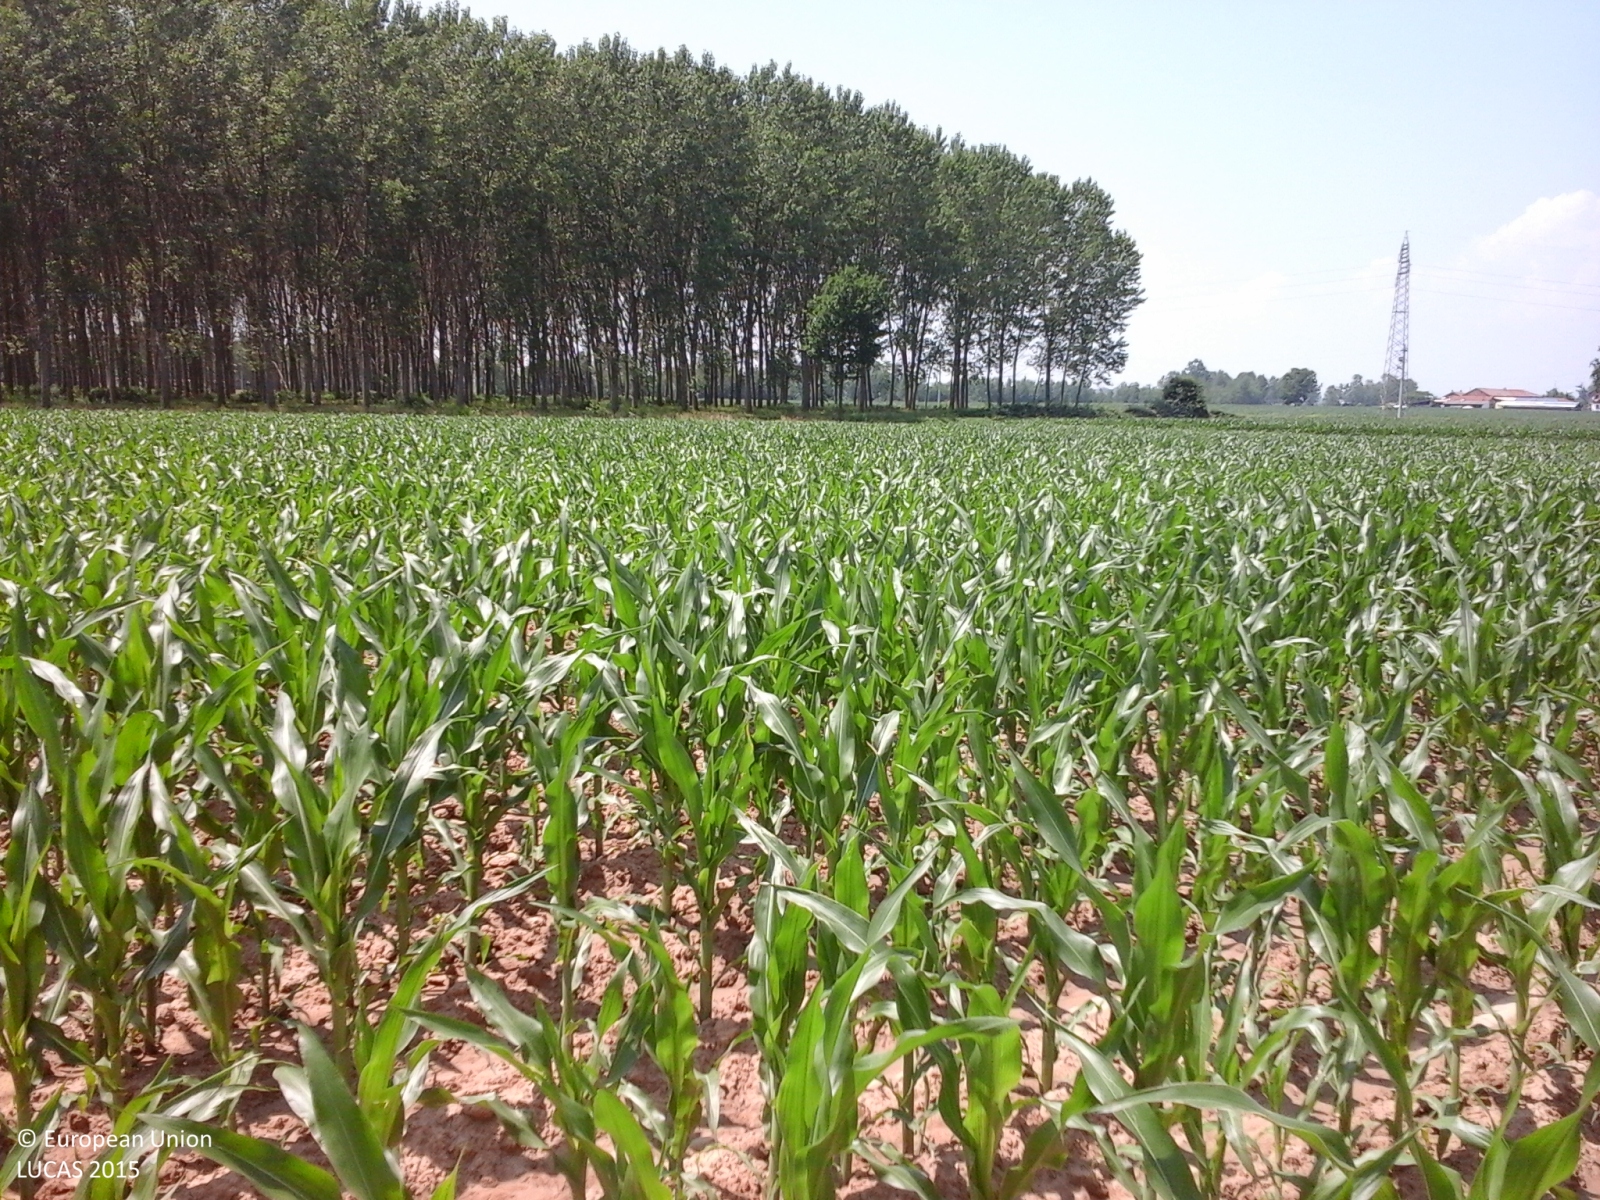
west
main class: Cropland
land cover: Common wheat
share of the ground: > 75 %
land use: Agriculture (excluding fallow land and kitchen gardens)
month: June
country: IT
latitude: 44.9042
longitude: 7.7878
